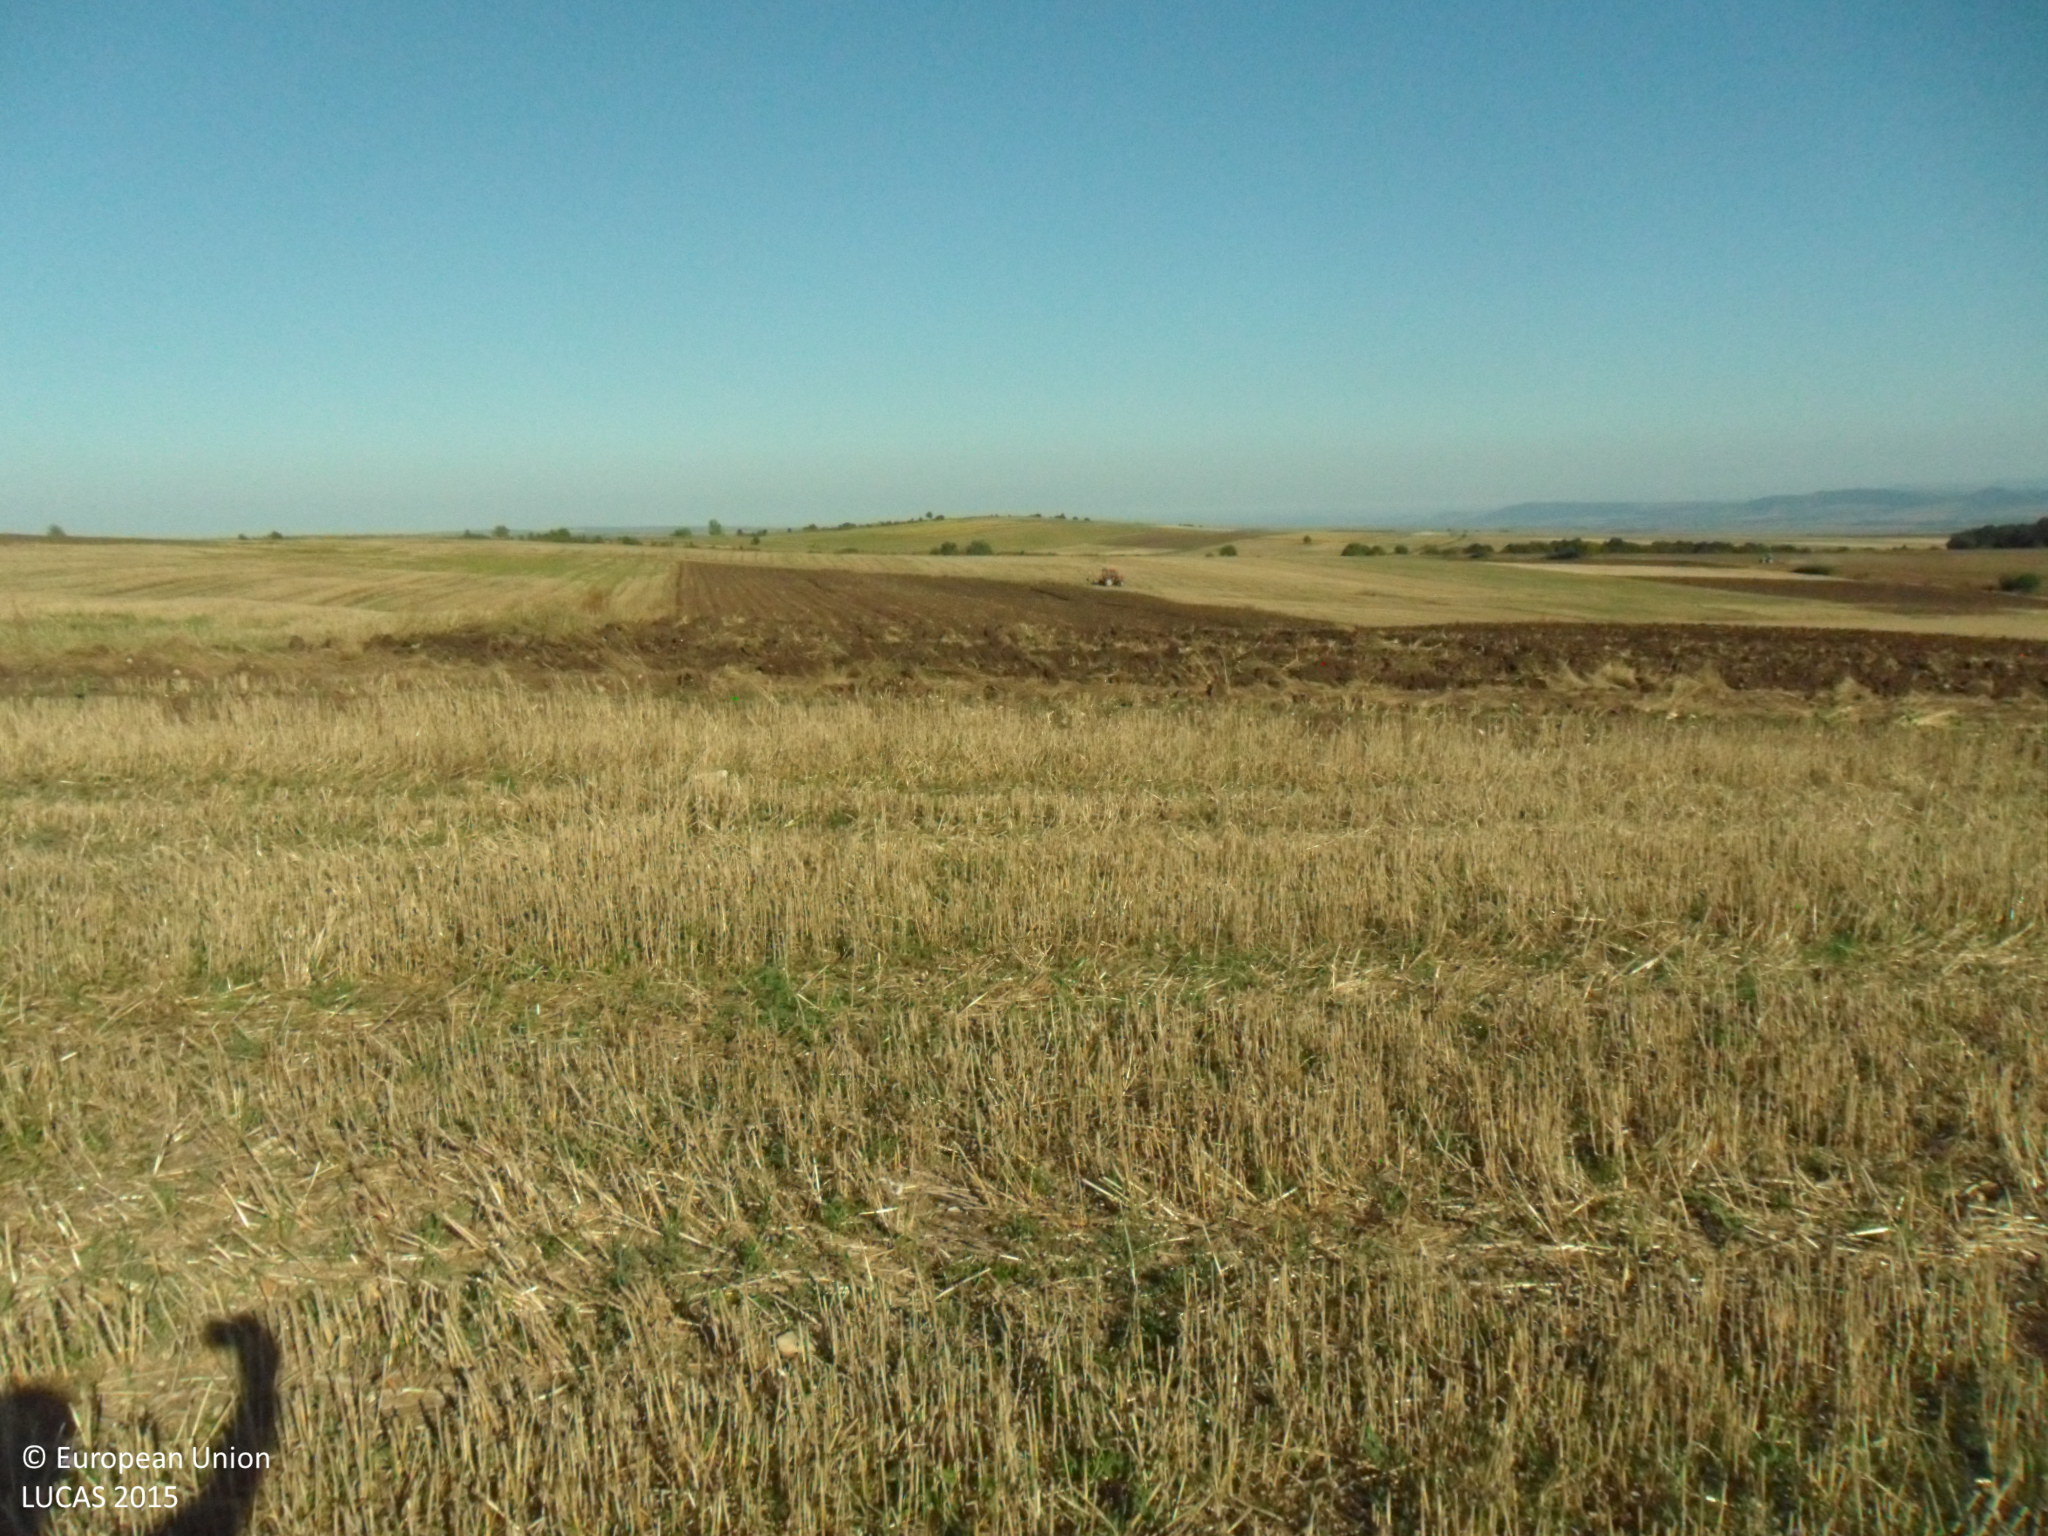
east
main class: Cropland
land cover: Common wheat
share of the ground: 10 - 25 %
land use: Agriculture (excluding fallow land and kitchen gardens)
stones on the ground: < 10 %
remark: Harvested field
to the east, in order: Common wheat; Grass margins; Tracks; Grass margins; Common wheat
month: September
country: BG
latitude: 43.2154
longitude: 27.1927
